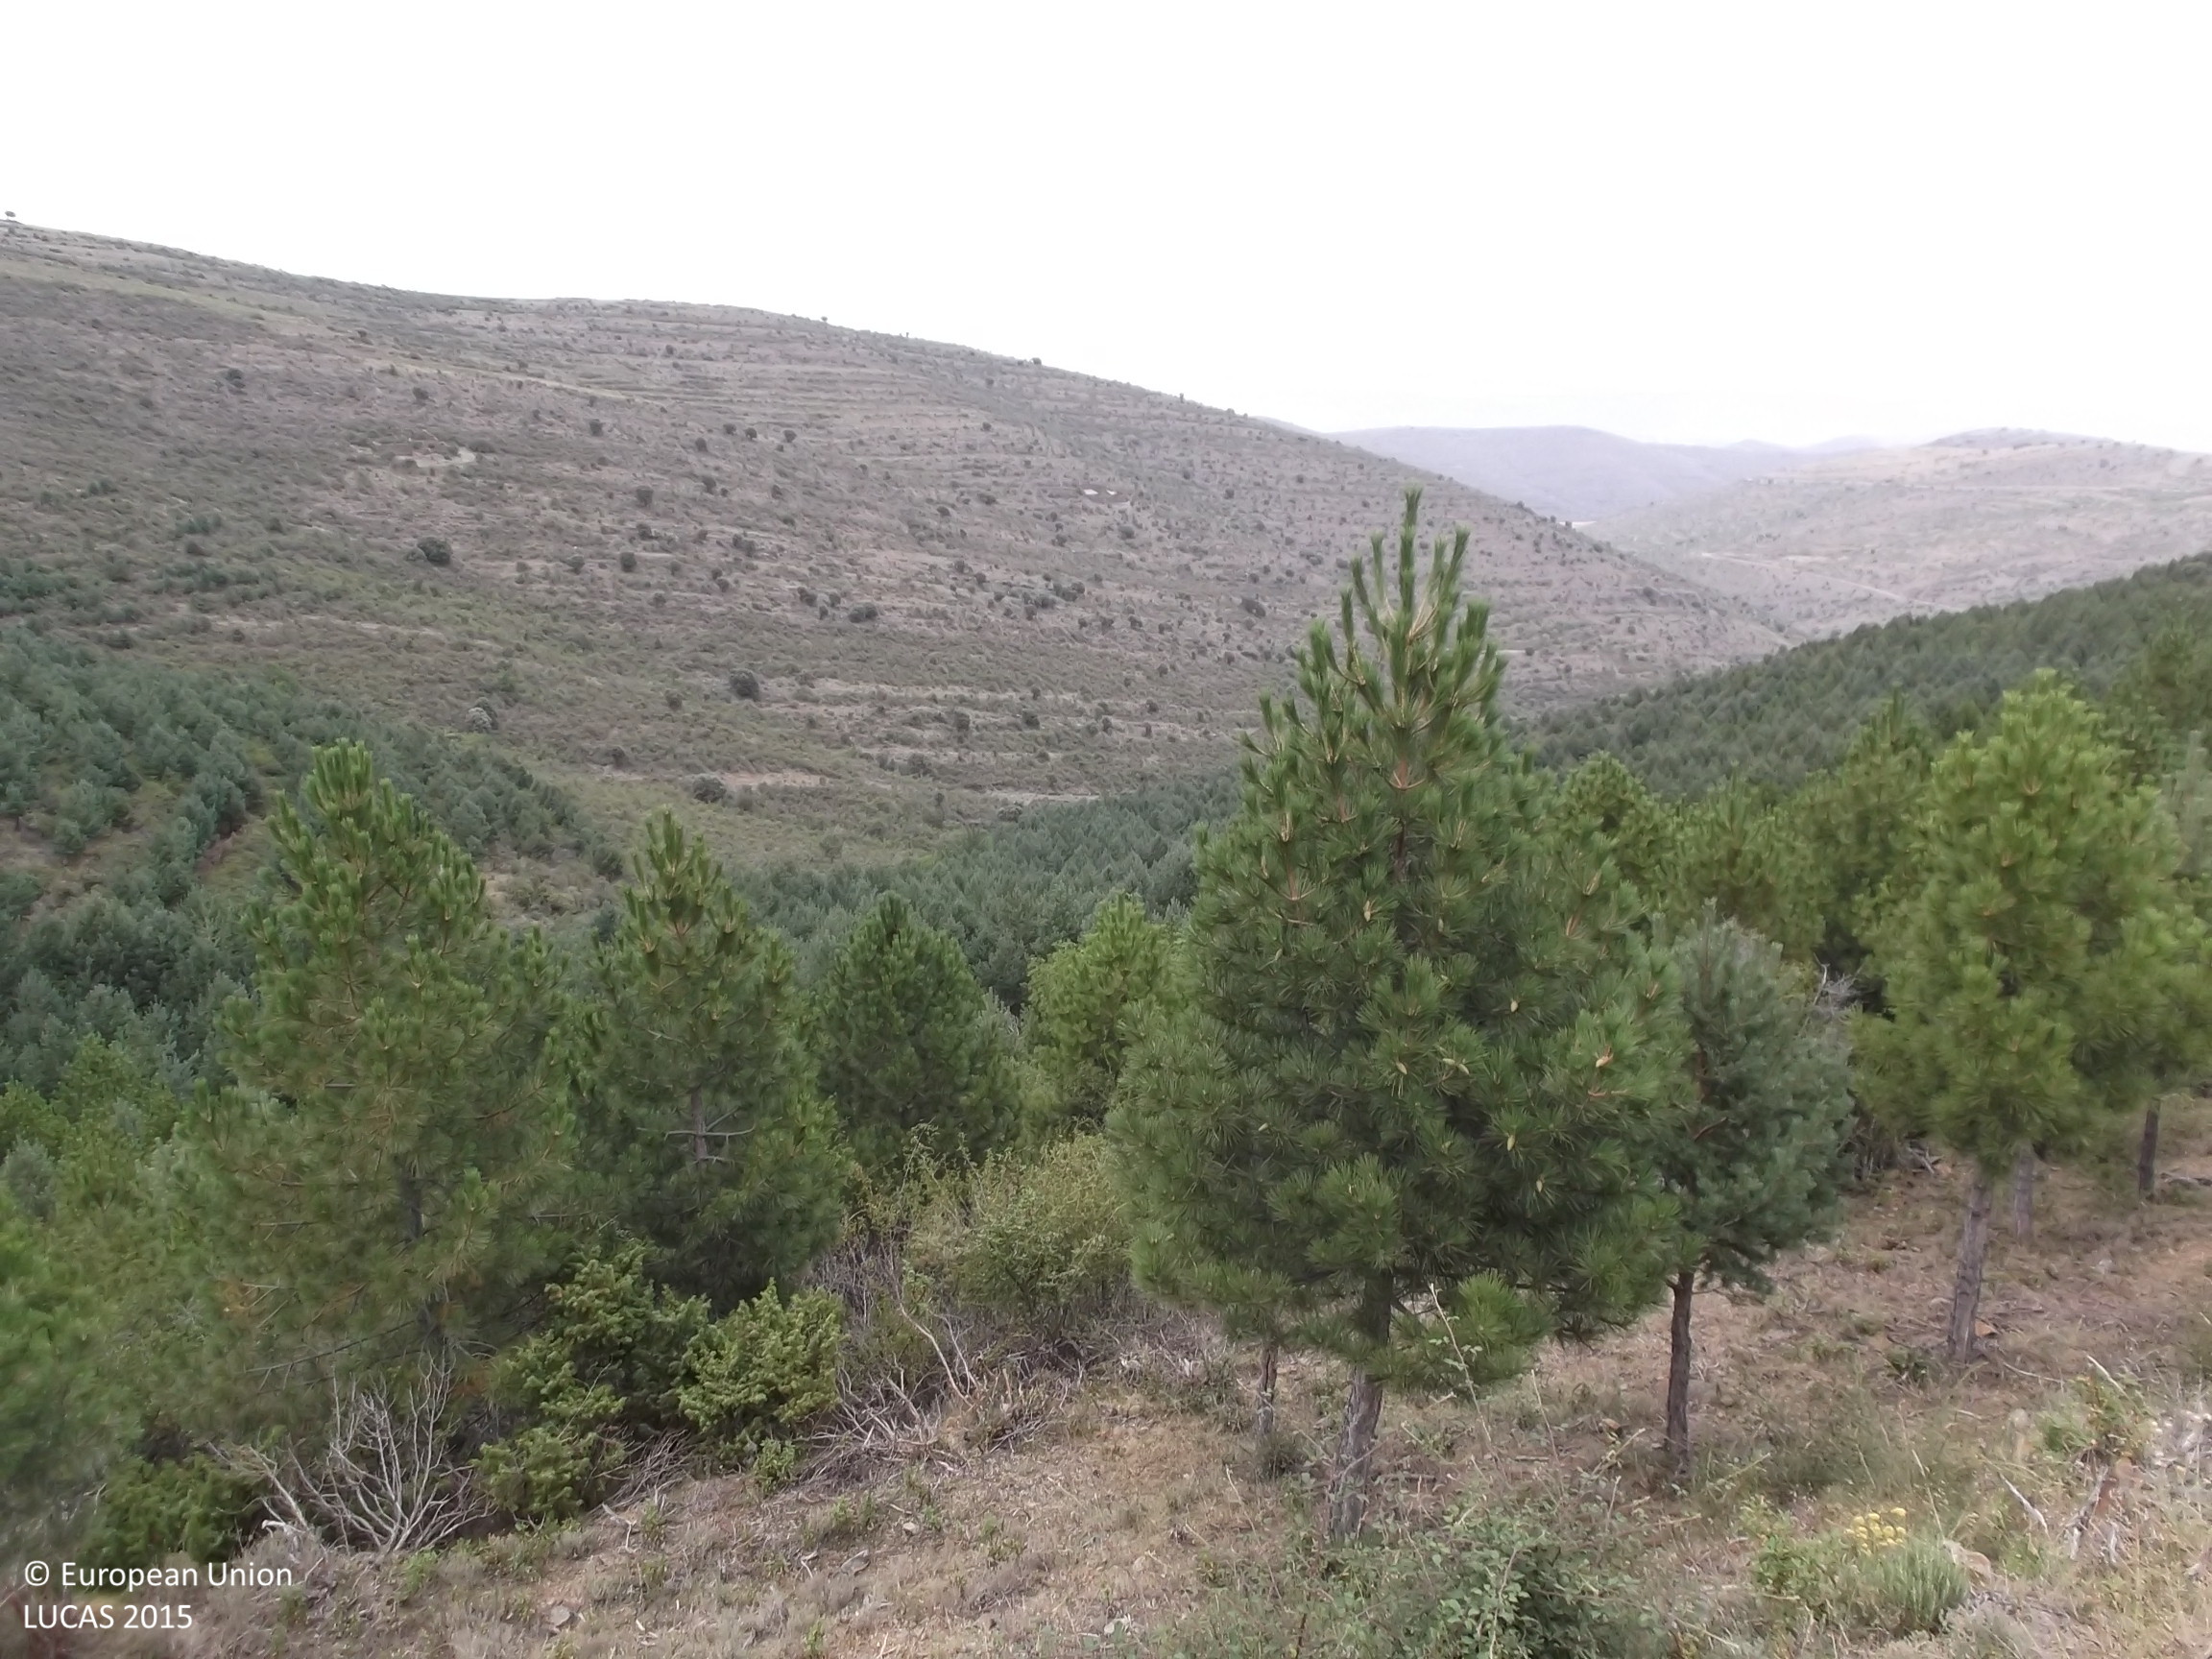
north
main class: Woodland
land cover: Pine dominated coniferous woodland
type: coniferous forest of the mediterranean region
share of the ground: > 75 %
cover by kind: coniferous forest trees 80 %, shrubs 20 %
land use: Forestry
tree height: < 5 m
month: July
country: ES
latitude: 42.0169
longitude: -2.1004
